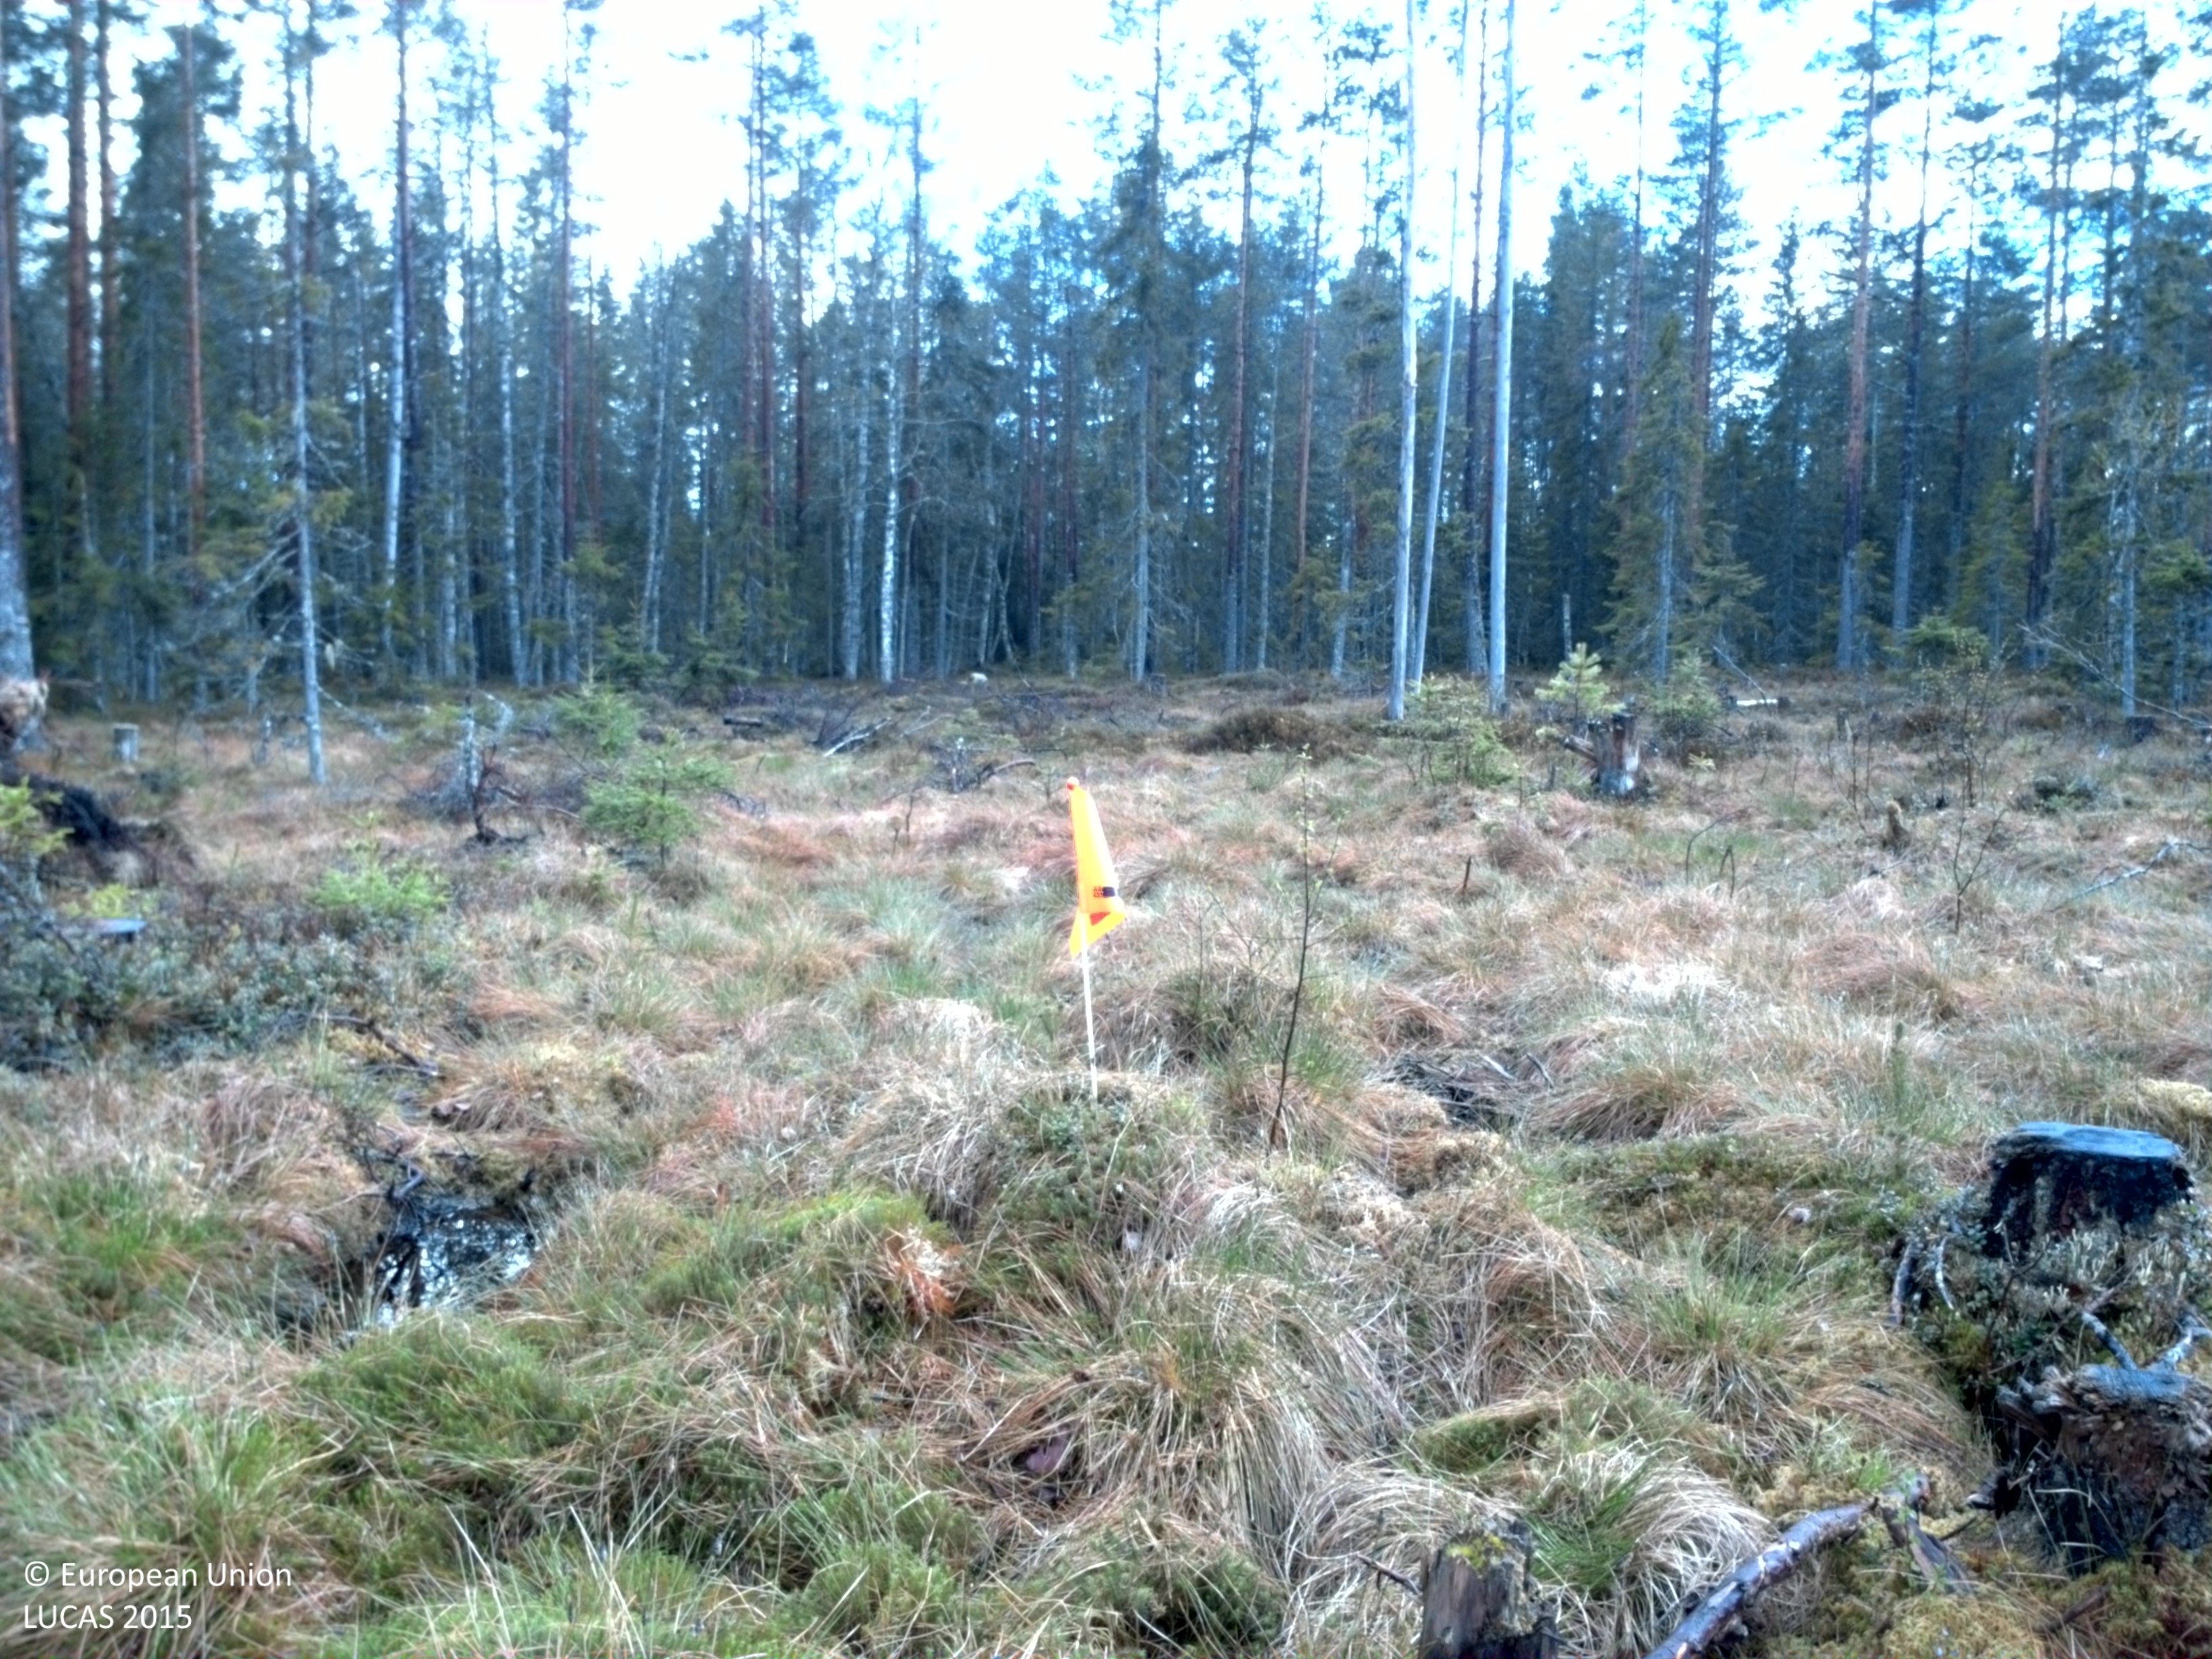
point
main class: Woodland
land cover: Spruce dominated mixed woodland
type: boreal forest
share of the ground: > 75 %
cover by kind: coniferous forest trees 55 %, broadleaved forest trees 25 %, herbaceous plants 10 %, shrubs 5 %, lichens and mosses 5 %
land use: Forestry
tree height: > 5 m
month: May
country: SE
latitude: 61.1444
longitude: 14.8339
